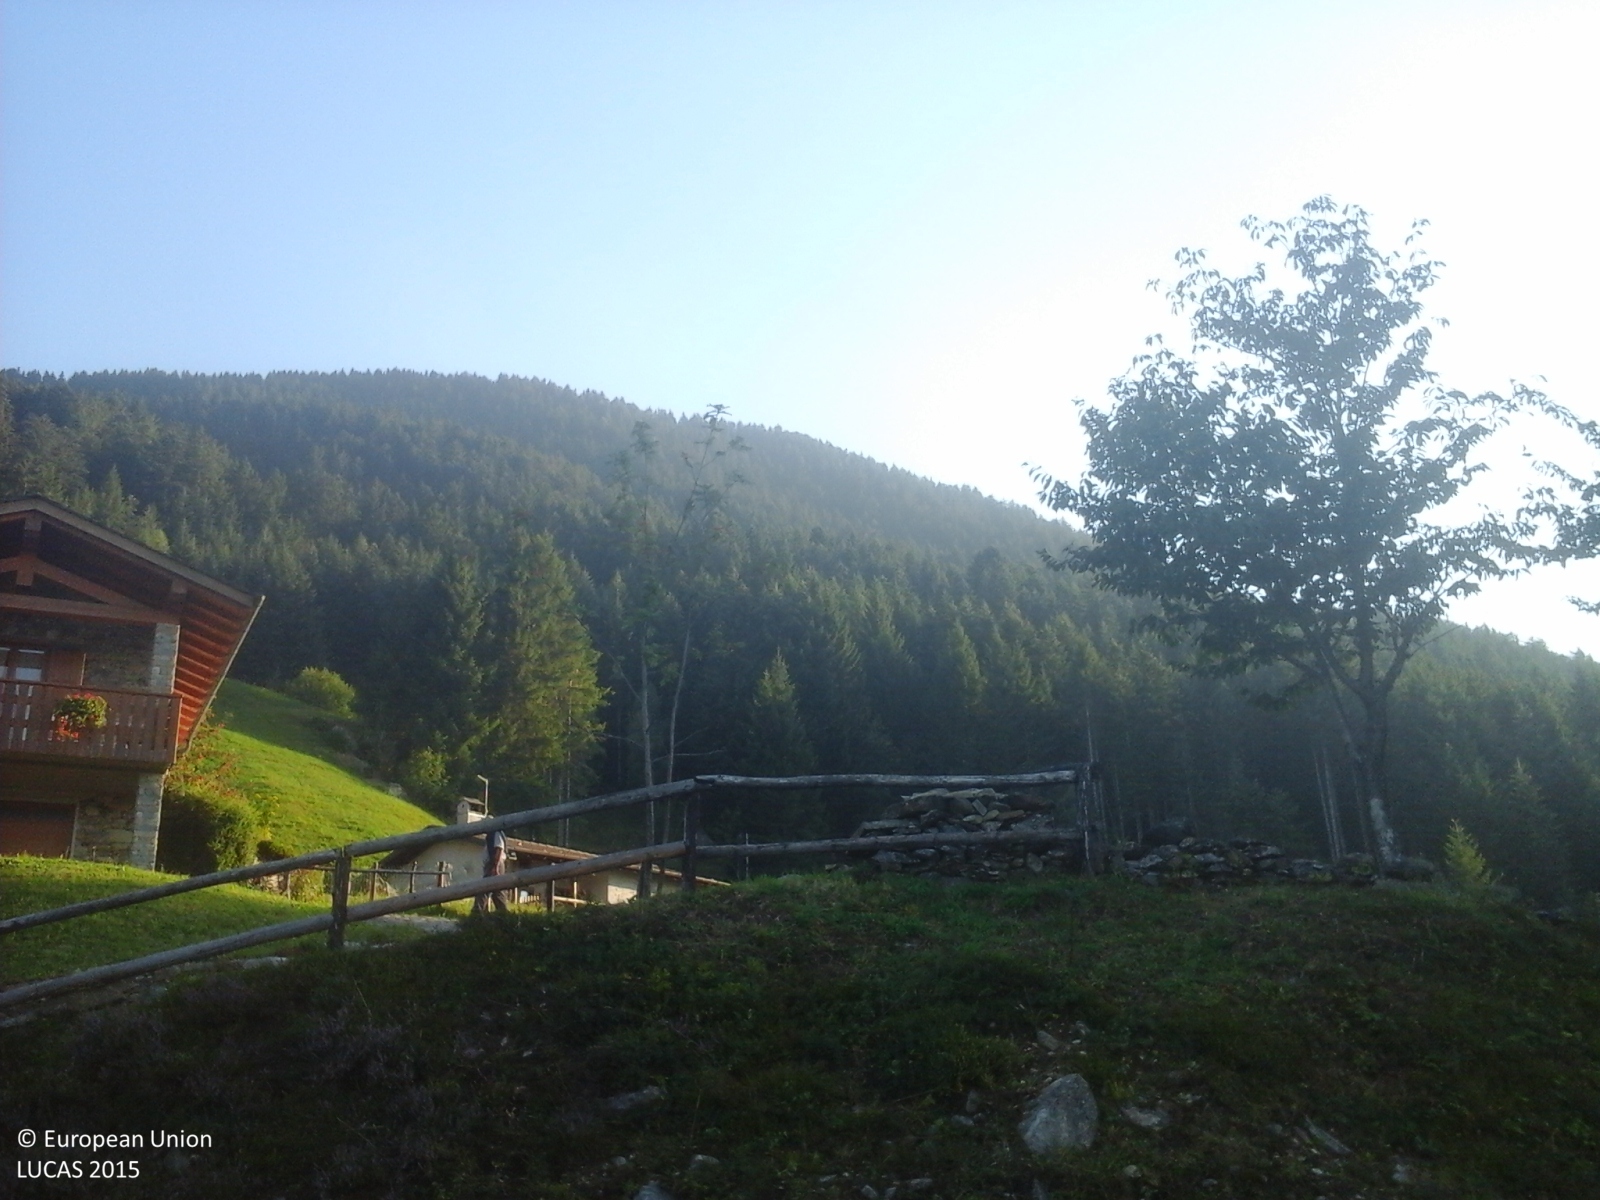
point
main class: Woodland
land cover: Spruce dominated coniferous woodland
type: alpine coniferous forest
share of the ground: > 75 %
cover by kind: coniferous forest trees 100 %
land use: Forestry
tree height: > 5 m
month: August
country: IT
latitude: 46.1158
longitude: 9.4961
